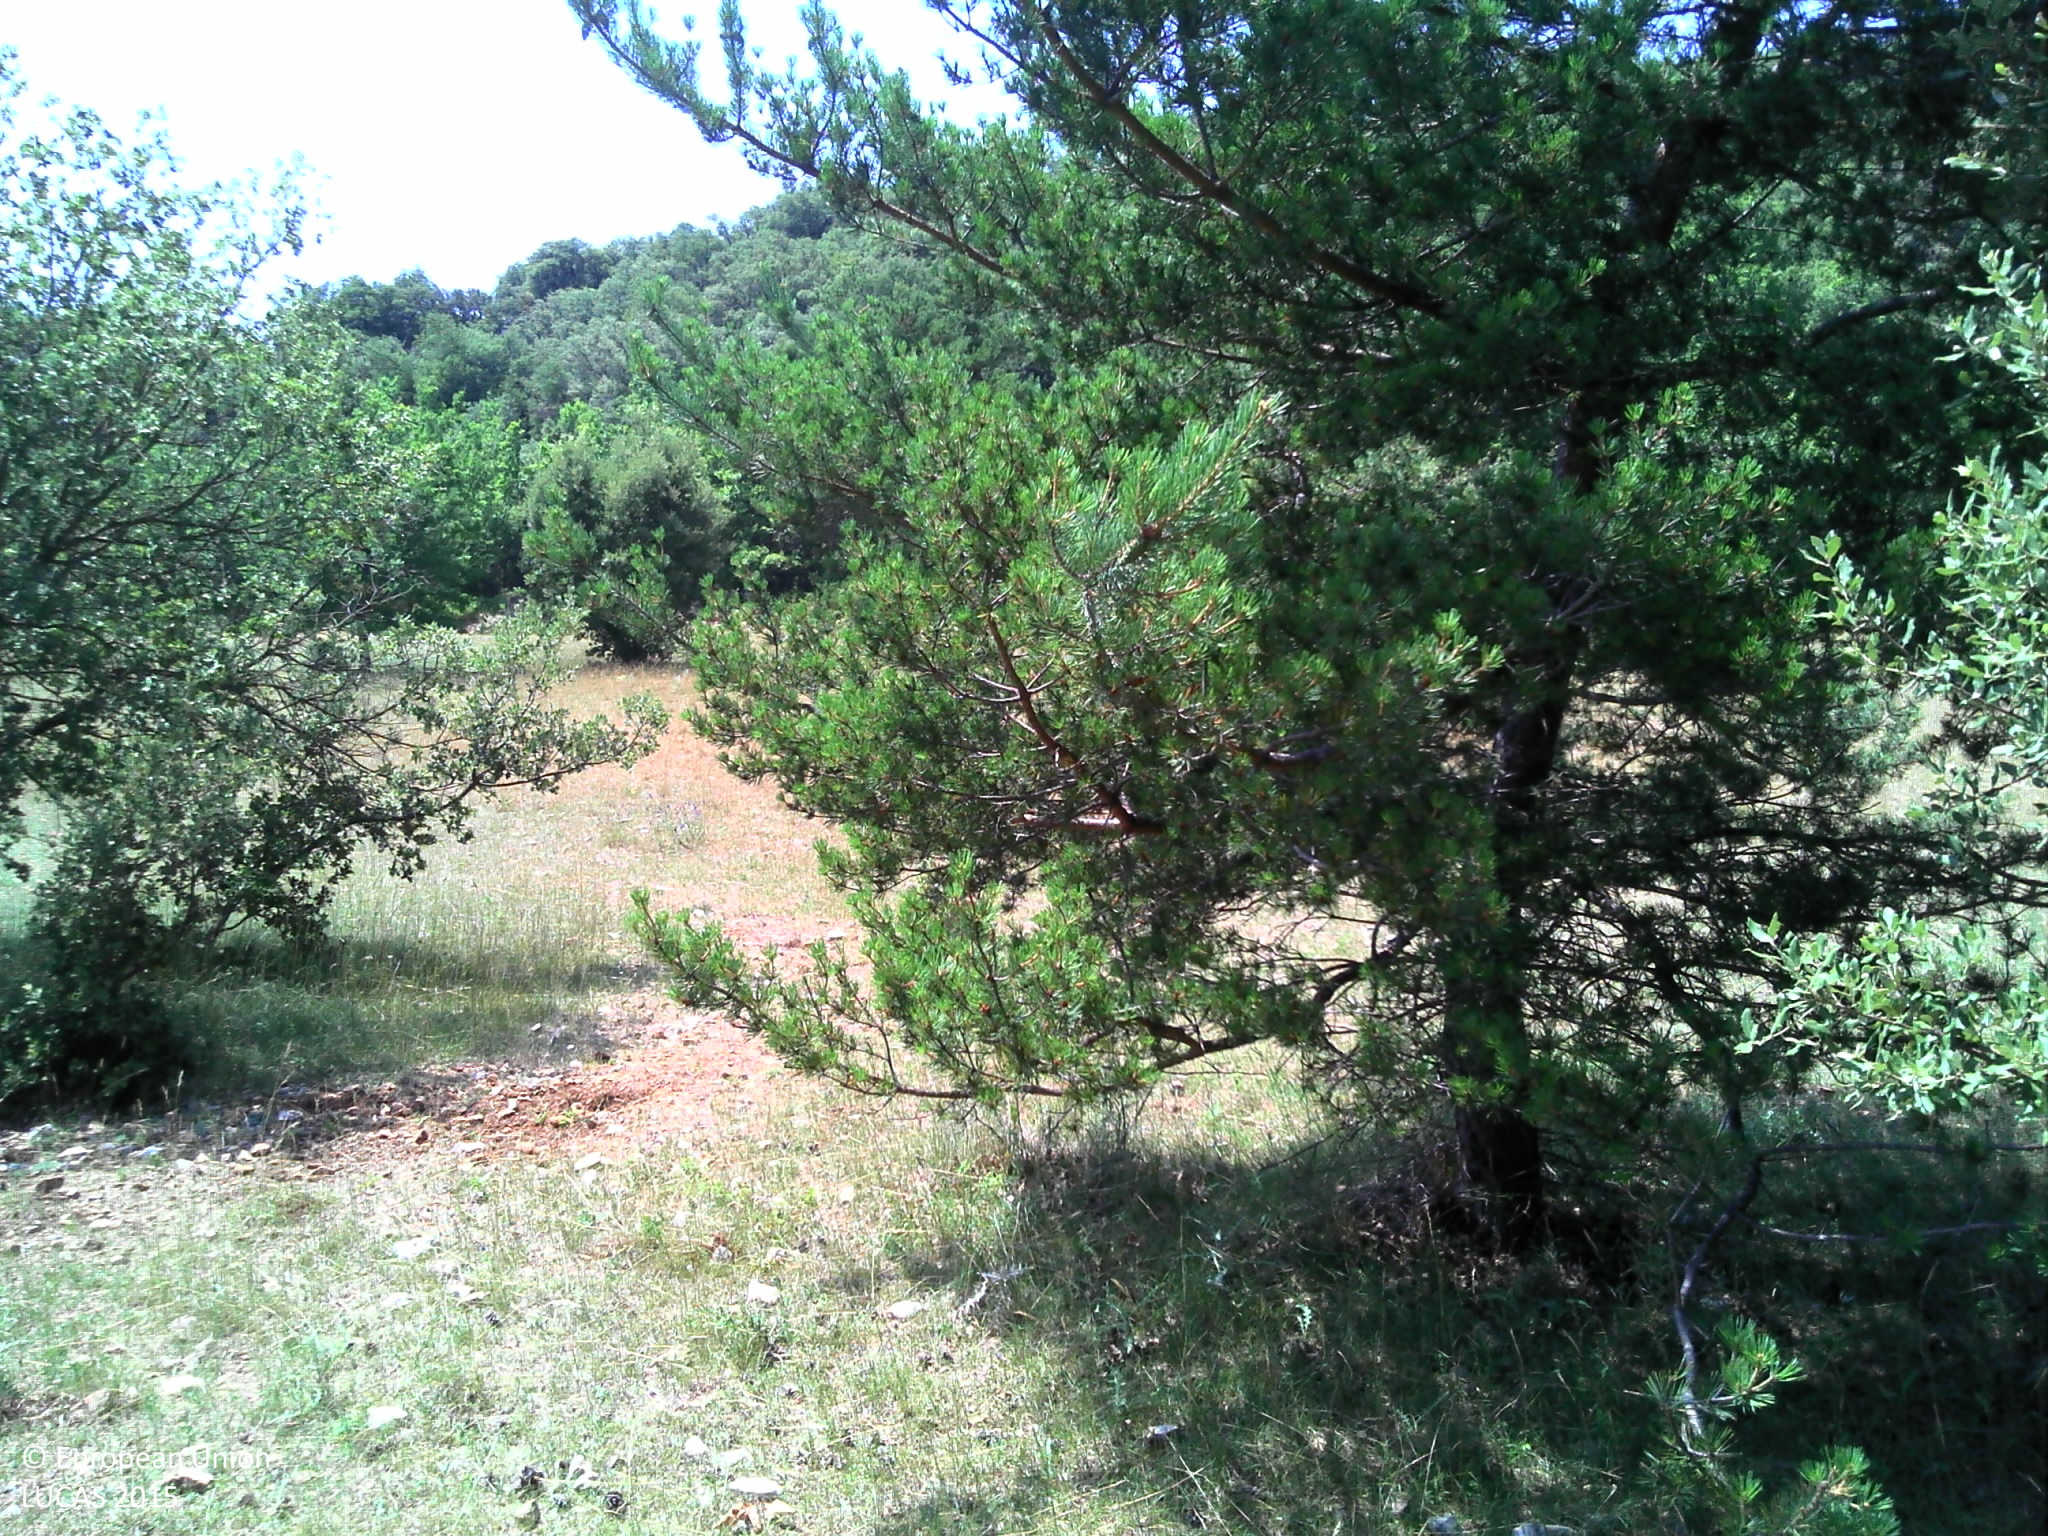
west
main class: Woodland
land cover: Broadleaved woodland
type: broadleaved evergreen forest
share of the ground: 50 - 75 %
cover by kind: herbaceous plants 45 %, broadleaved forest trees 40 %, shrubs 10 %, coniferous forest trees 5 %
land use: Agriculture (excluding fallow land and kitchen gardens)
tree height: > 5 m
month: July
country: FR
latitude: 44.0095
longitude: 5.3061
